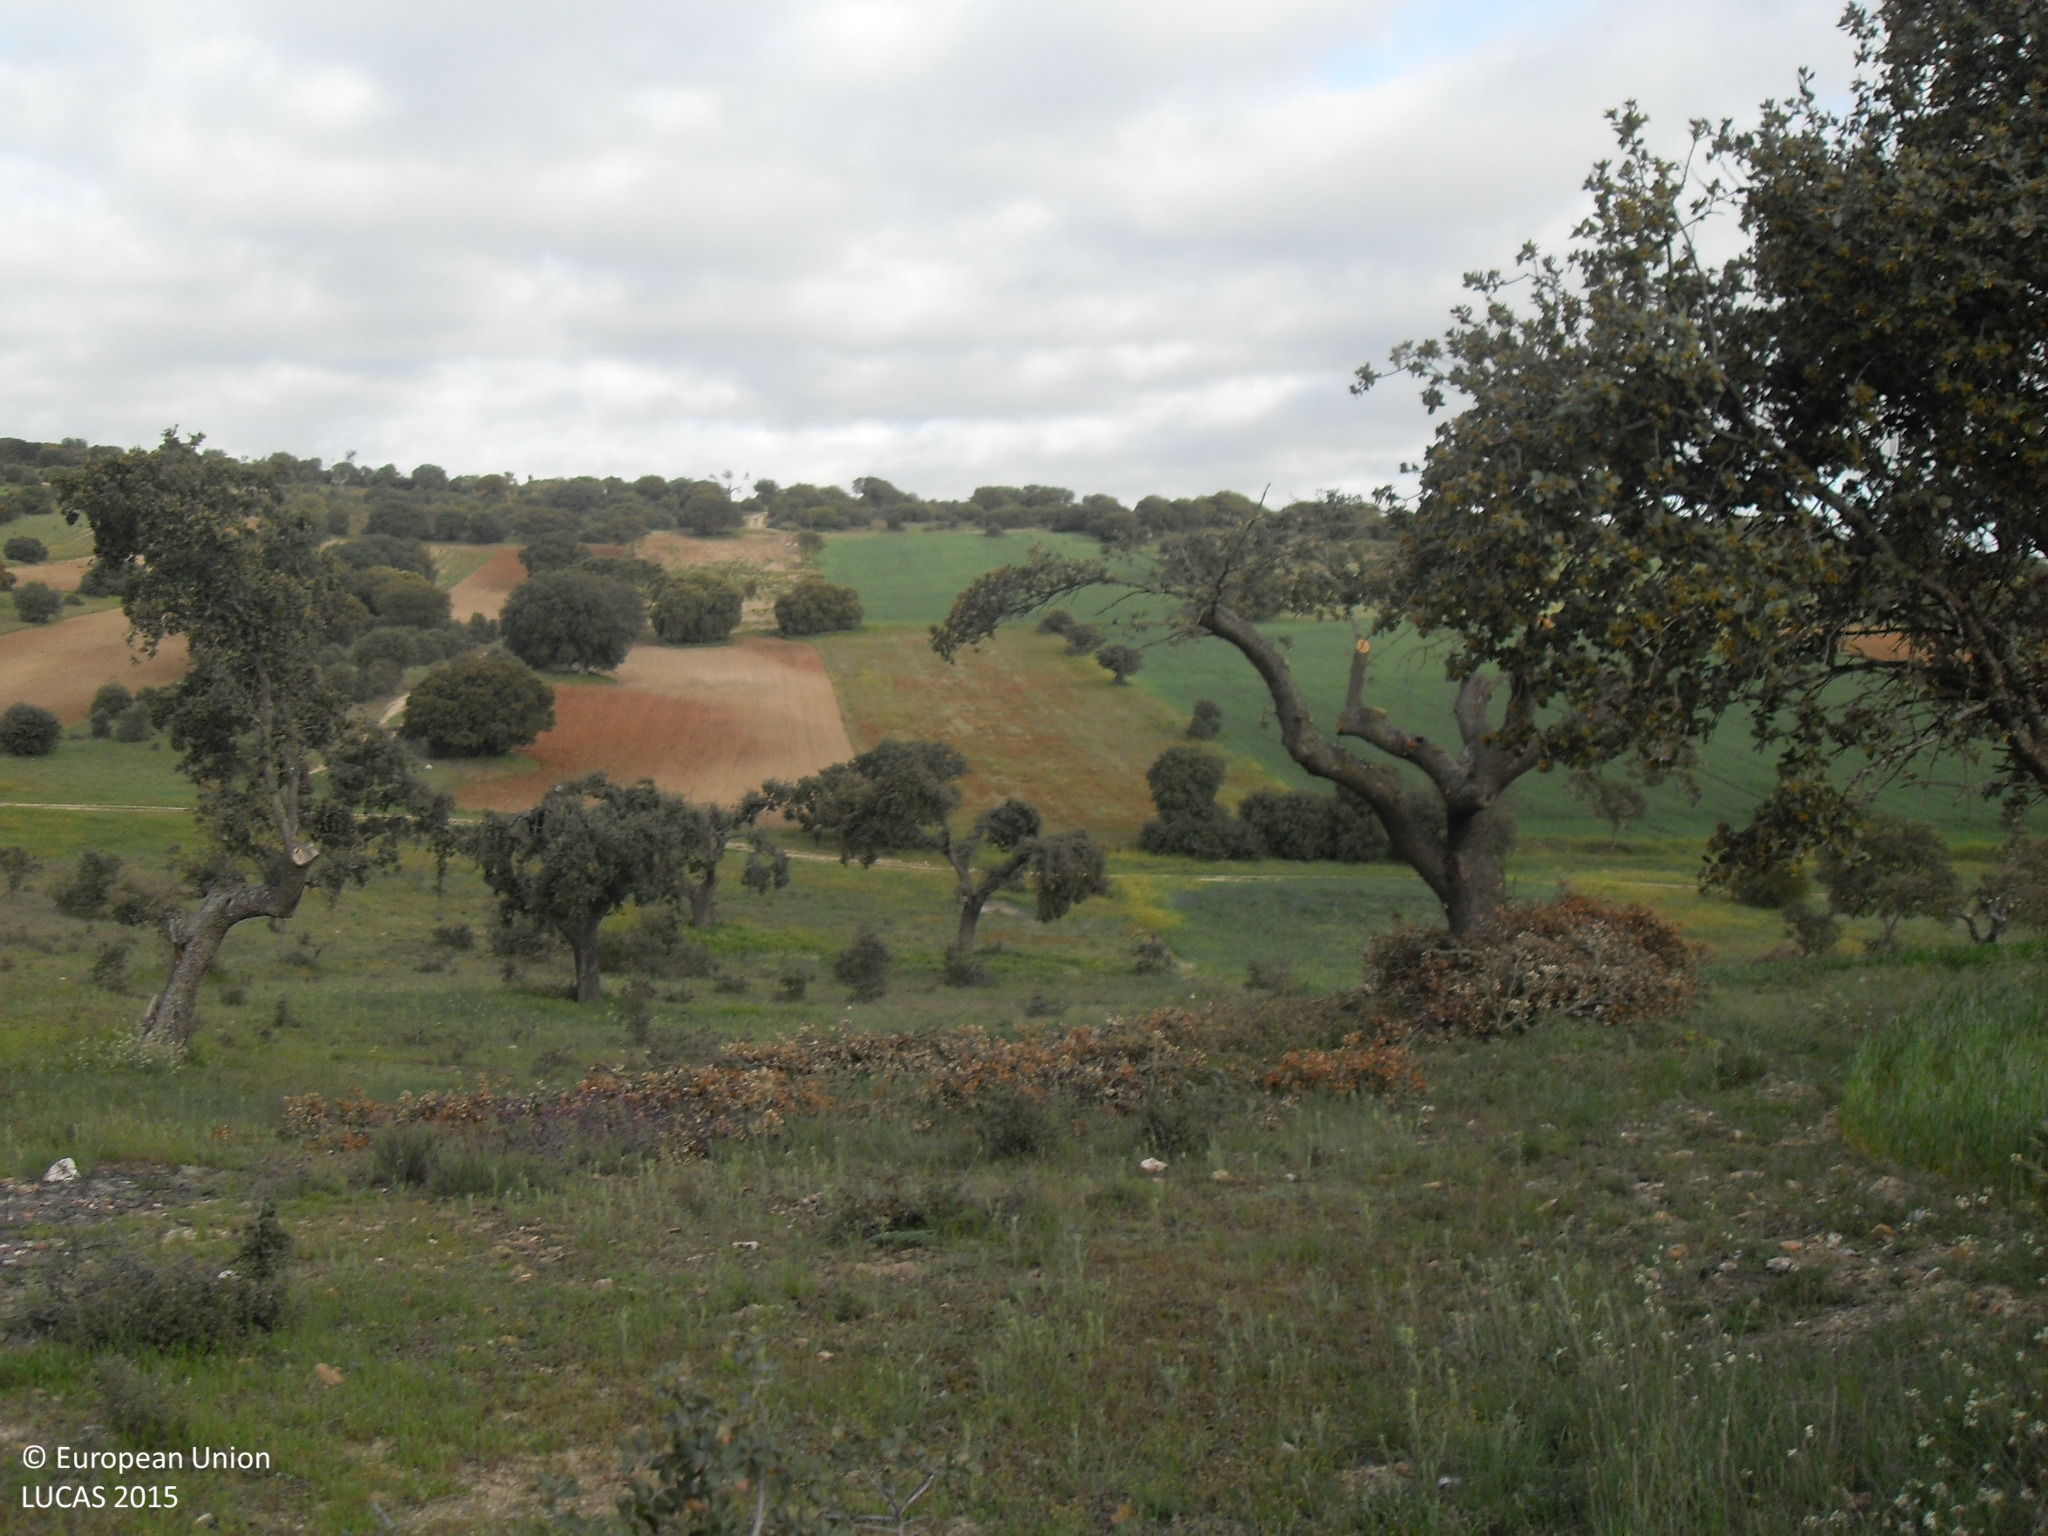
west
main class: Woodland
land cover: Broadleaved woodland
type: broadleaved evergreen forest
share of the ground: 10 - 25 %
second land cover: Grassland without tree/shrub cover
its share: > 75 %
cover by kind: herbaceous plants 85 %, broadleaved forest trees 15 %
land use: Forestry
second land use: Agriculture (excluding fallow land and kitchen gardens)
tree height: > 5 m
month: May
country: ES
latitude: 40.8122
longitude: -5.1327
